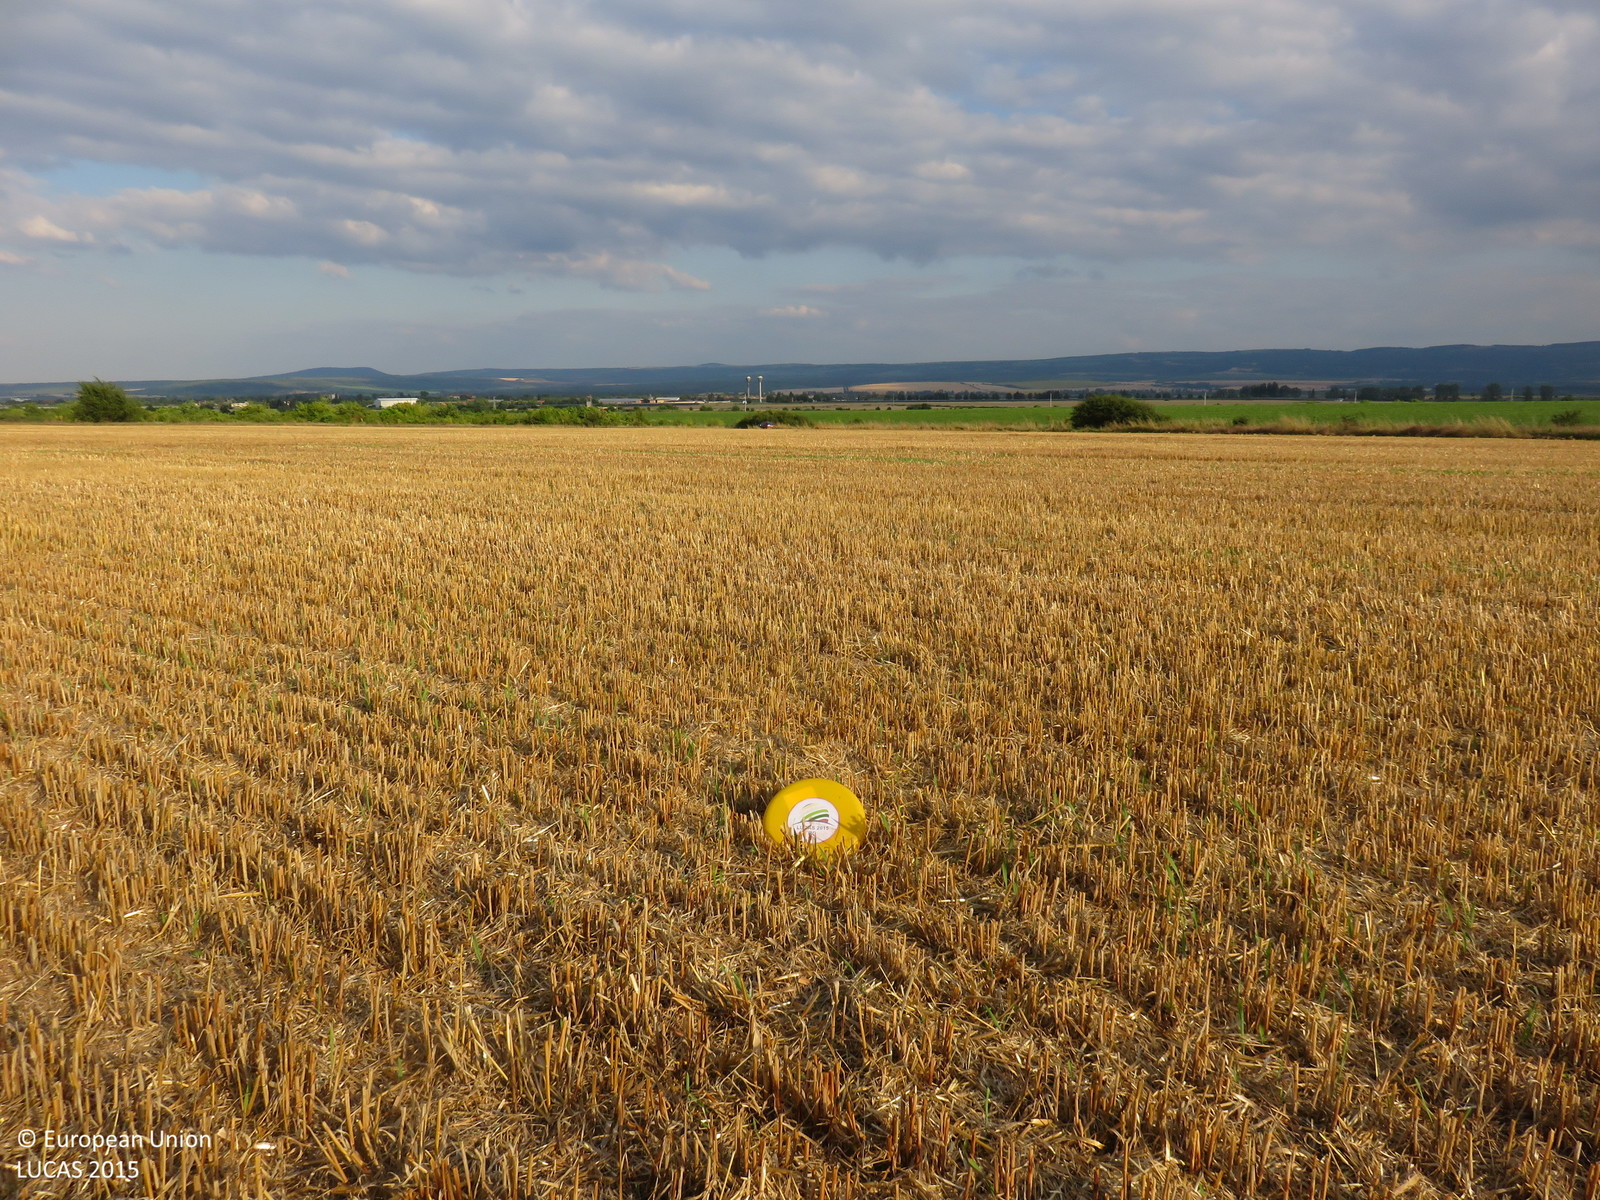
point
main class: Cropland
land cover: Barley
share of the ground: > 75 %
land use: Agriculture (excluding fallow land and kitchen gardens)
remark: Harvested field
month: June
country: BG
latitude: 43.3221
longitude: 25.0278
